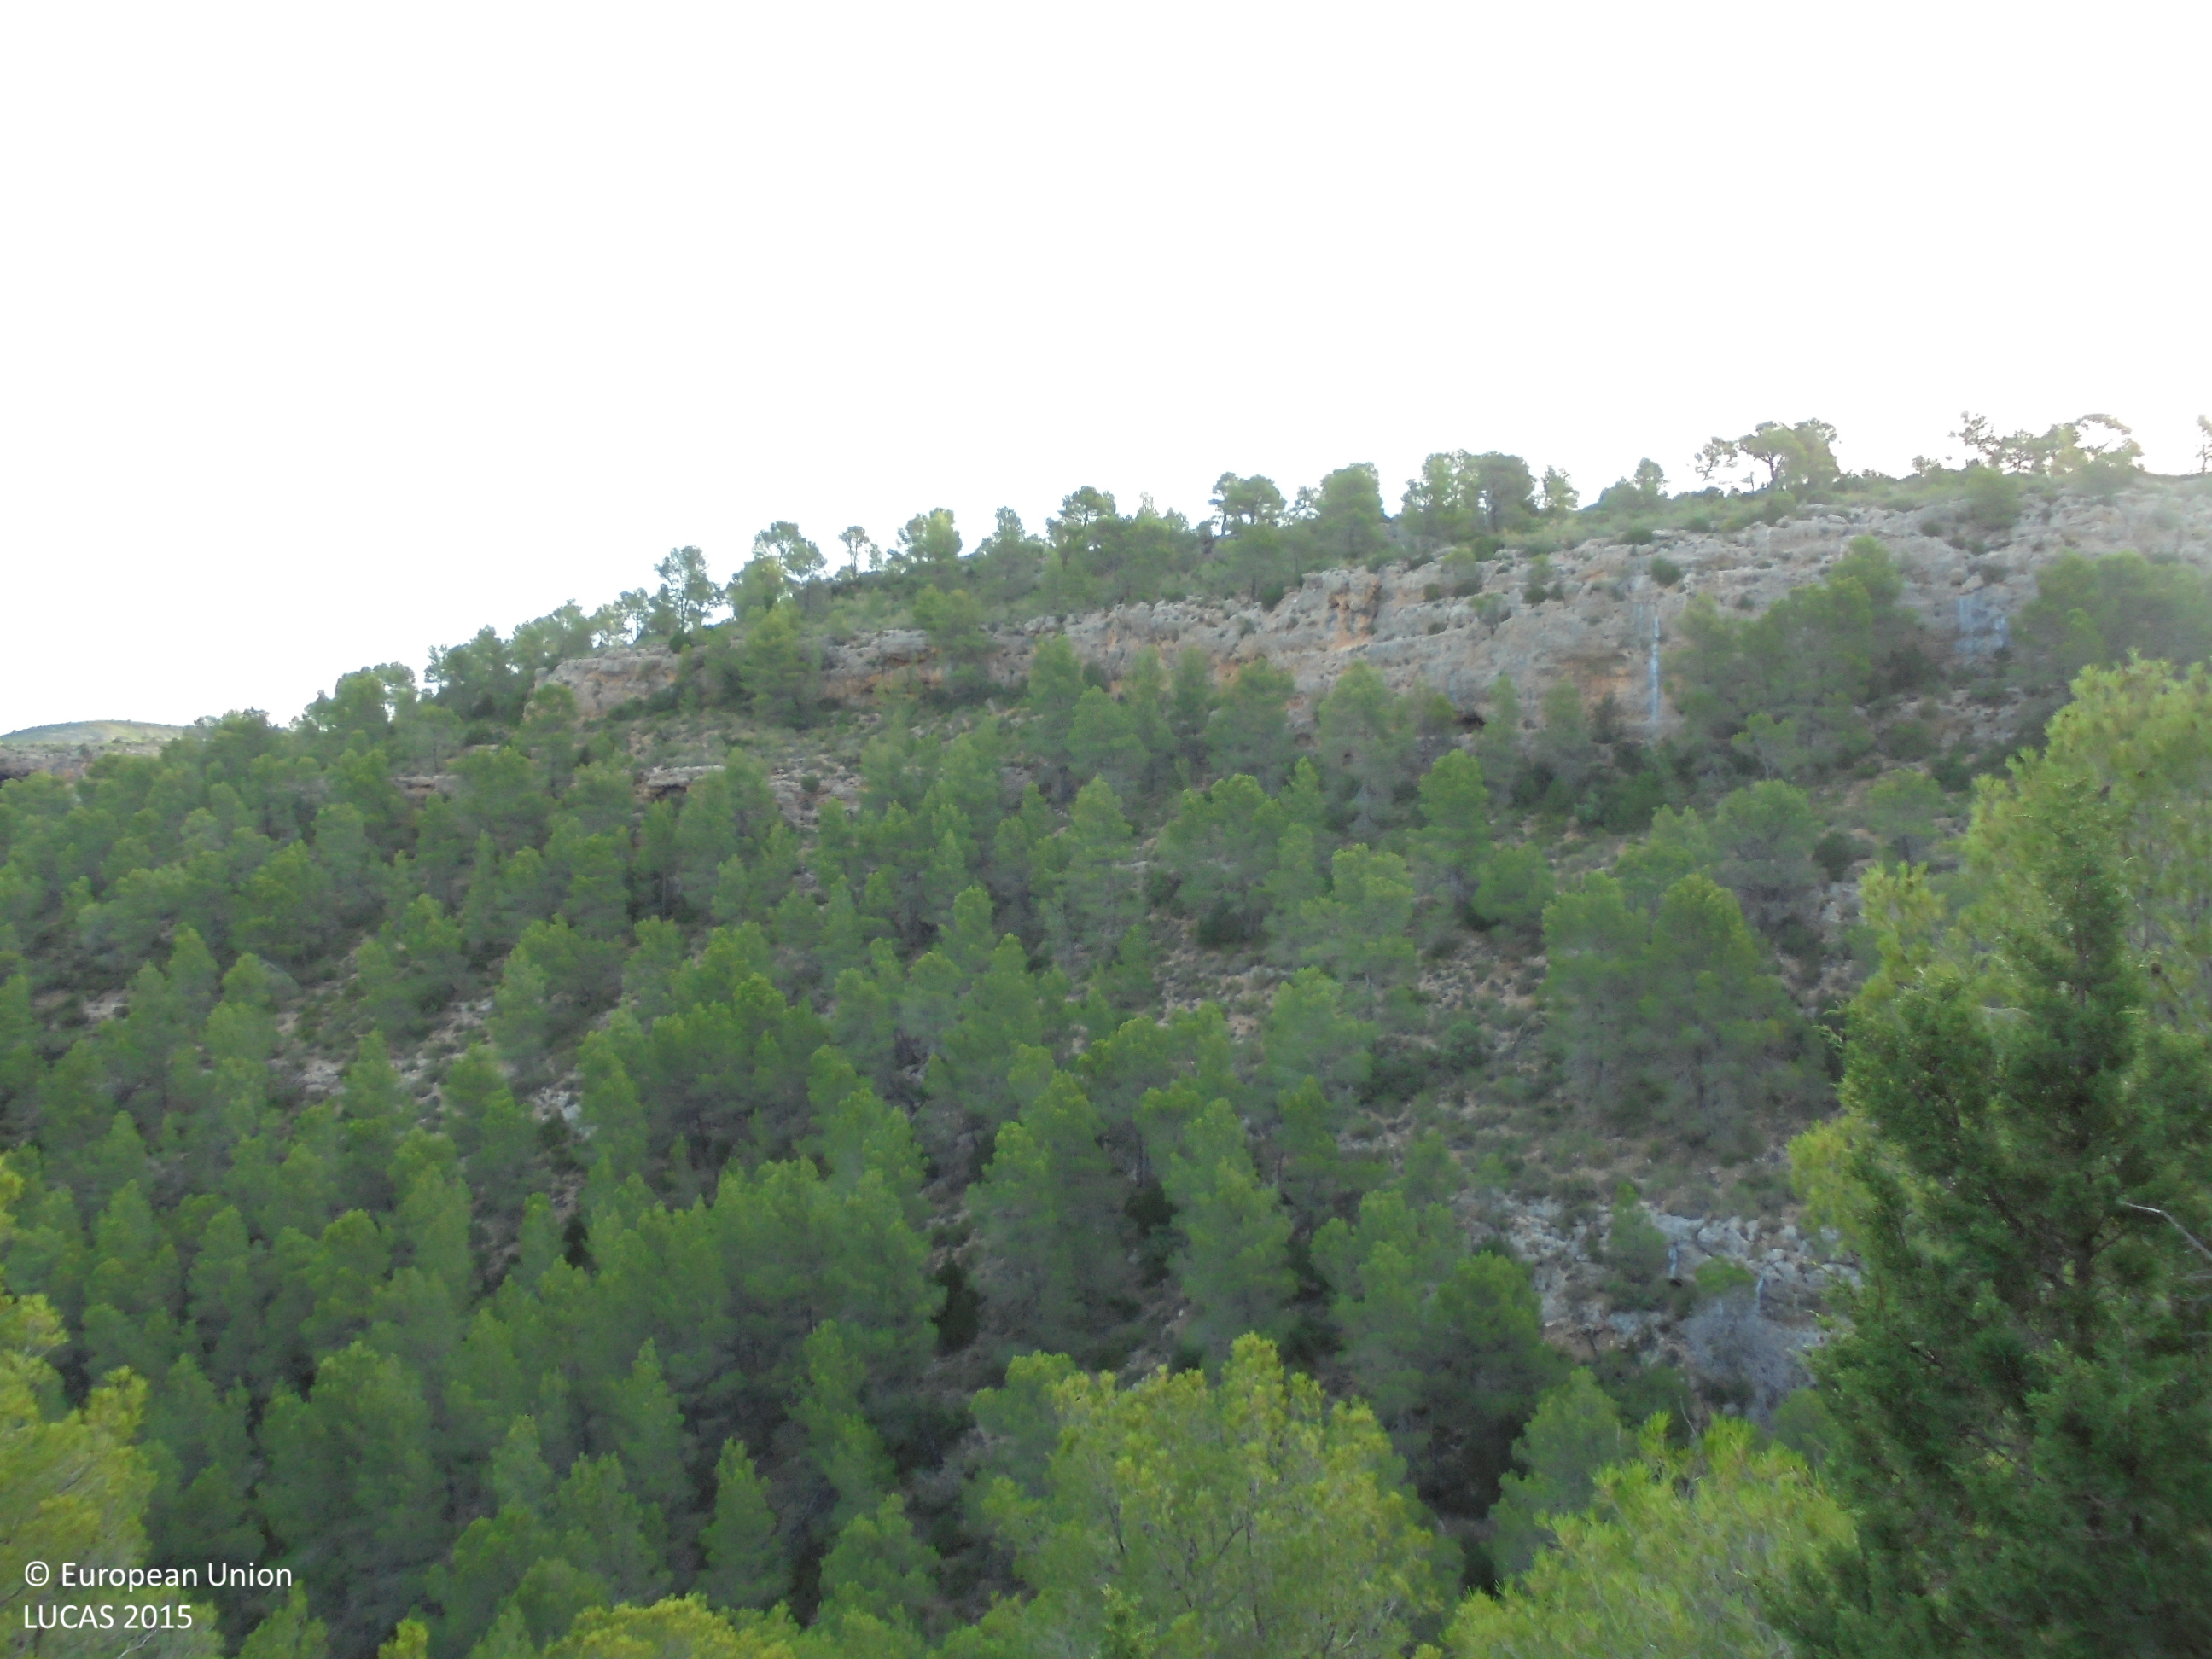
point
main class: Woodland
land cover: Pine dominated coniferous woodland
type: coniferous forest of the mediterranean region
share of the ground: 50 - 75 %
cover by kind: coniferous forest trees 70 %, shrubs 20 %, unconsolidated bare surface 10 %
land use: Semi-natural and natural areas not in use
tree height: > 5 m
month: August
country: ES
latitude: 39.1154
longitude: -1.0185
